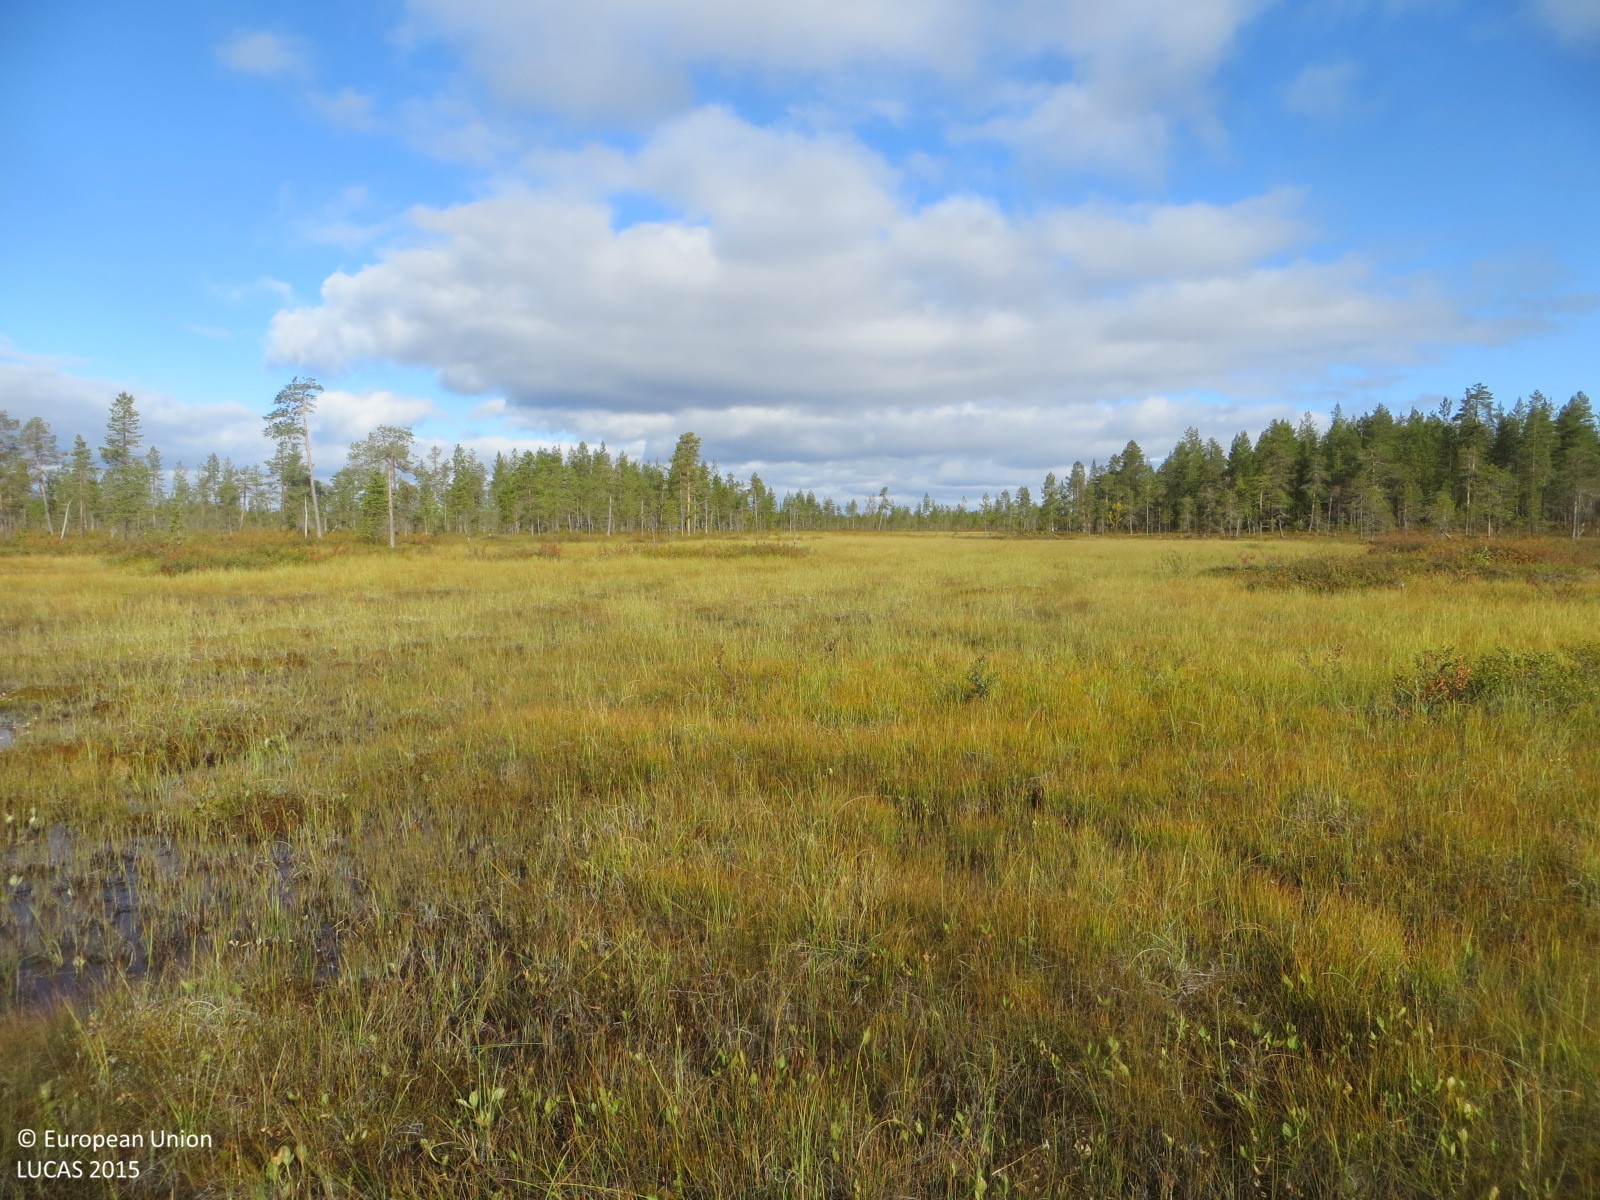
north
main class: Woodland
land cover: Pine dominated coniferous woodland
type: mire and swamp forests
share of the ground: 50 - 75 %
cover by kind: coniferous forest trees 50 %, shrubs 50 %
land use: Semi-natural and natural areas not in use
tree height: > 5 m
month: September
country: FI
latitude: 68.1527
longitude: 24.8355
